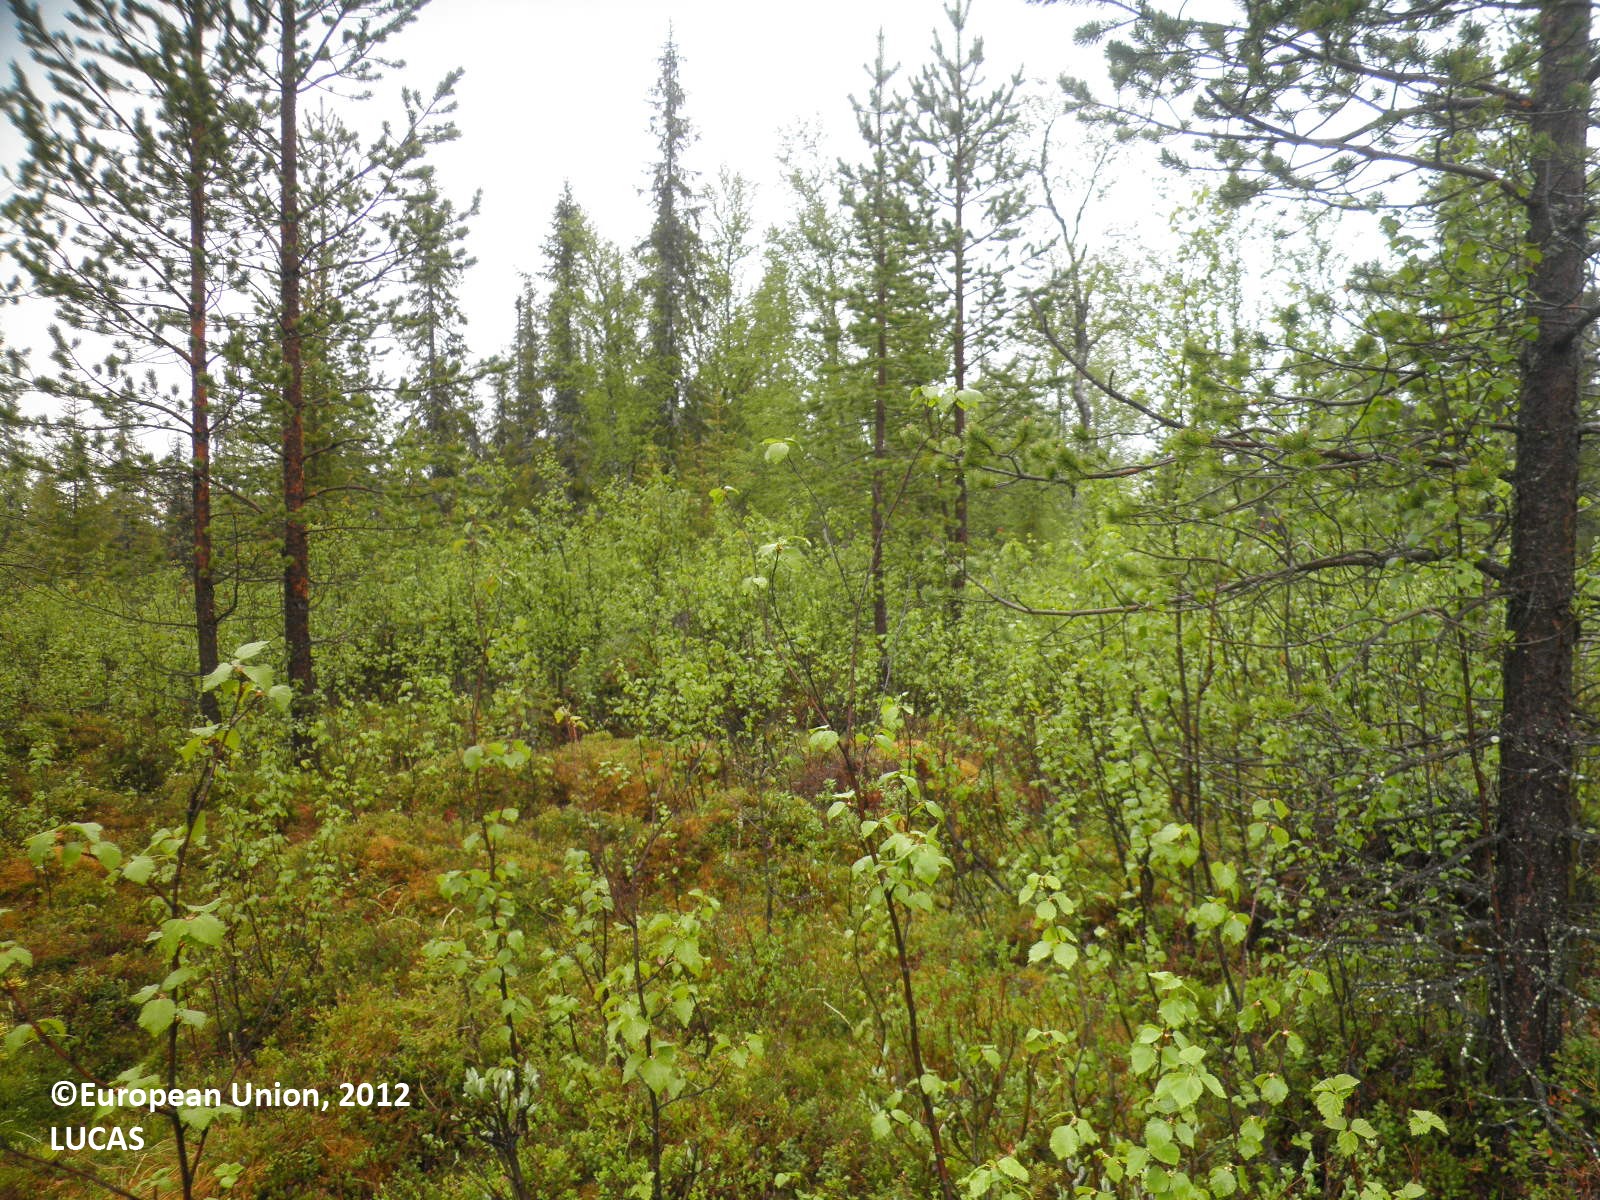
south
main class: Woodland
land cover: Pine dominated mixed woodland
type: boreal forest
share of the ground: 10 - 25 %
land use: Forestry
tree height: > 5 m
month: June
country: FI
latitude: 67.9987
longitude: 25.7617
